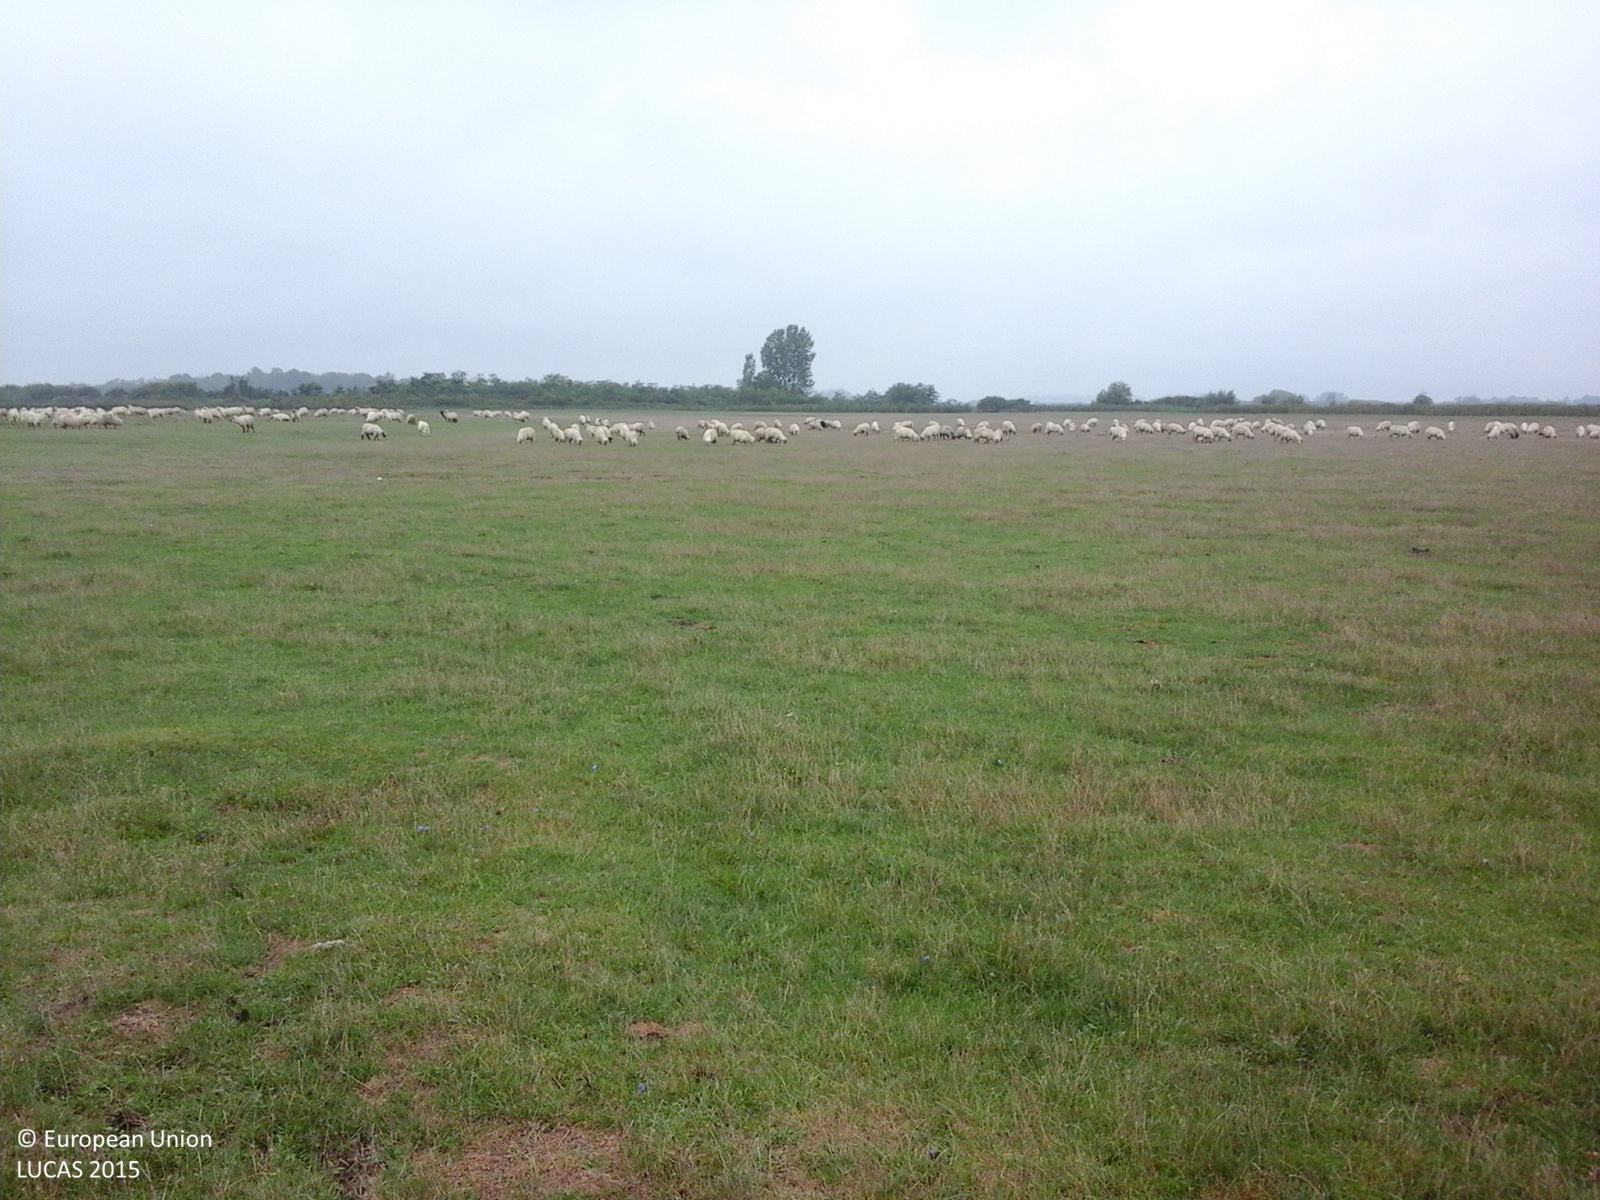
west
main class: Grassland
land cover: Grassland without tree/shrub cover
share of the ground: > 75 %
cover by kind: herbaceous plants 100 %
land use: Agriculture (excluding fallow land and kitchen gardens)
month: September
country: RO
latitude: 46.9823
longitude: 21.6775
